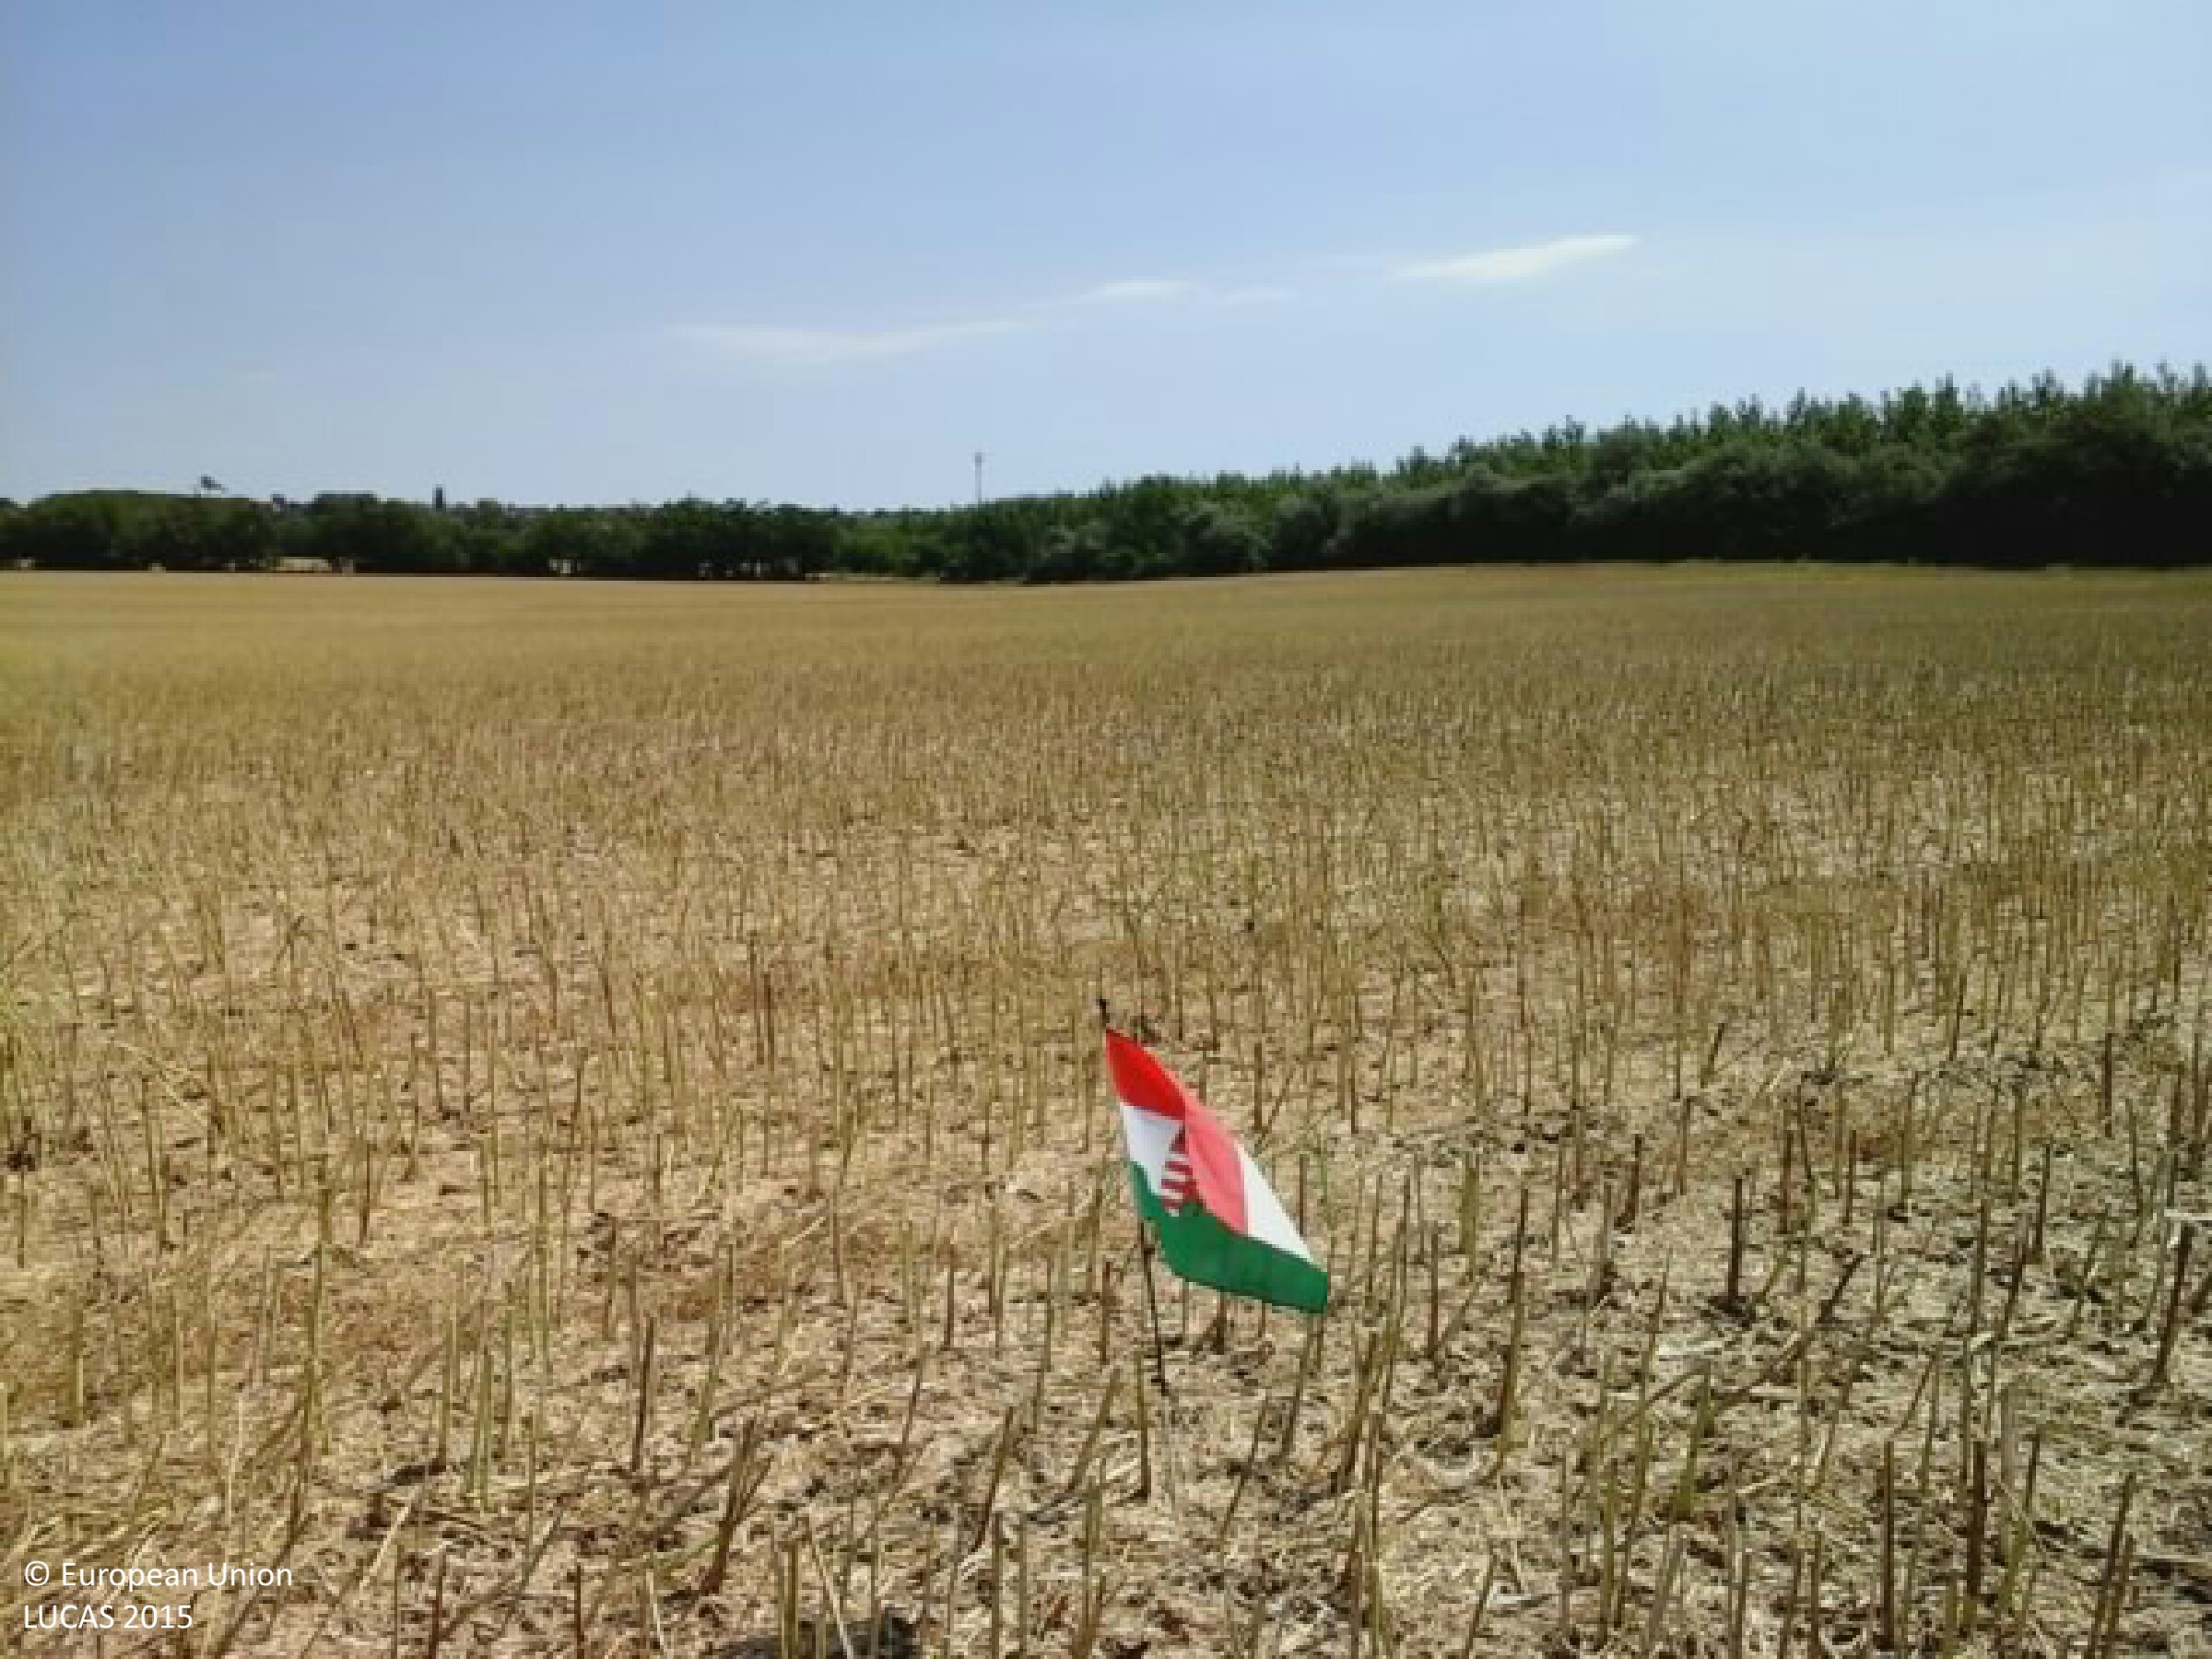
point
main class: Cropland
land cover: Rape and turnip rape
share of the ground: > 75 %
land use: Agriculture (excluding fallow land and kitchen gardens)
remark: Harvested field
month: June
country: HU
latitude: 47.4501
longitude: 19.2901
